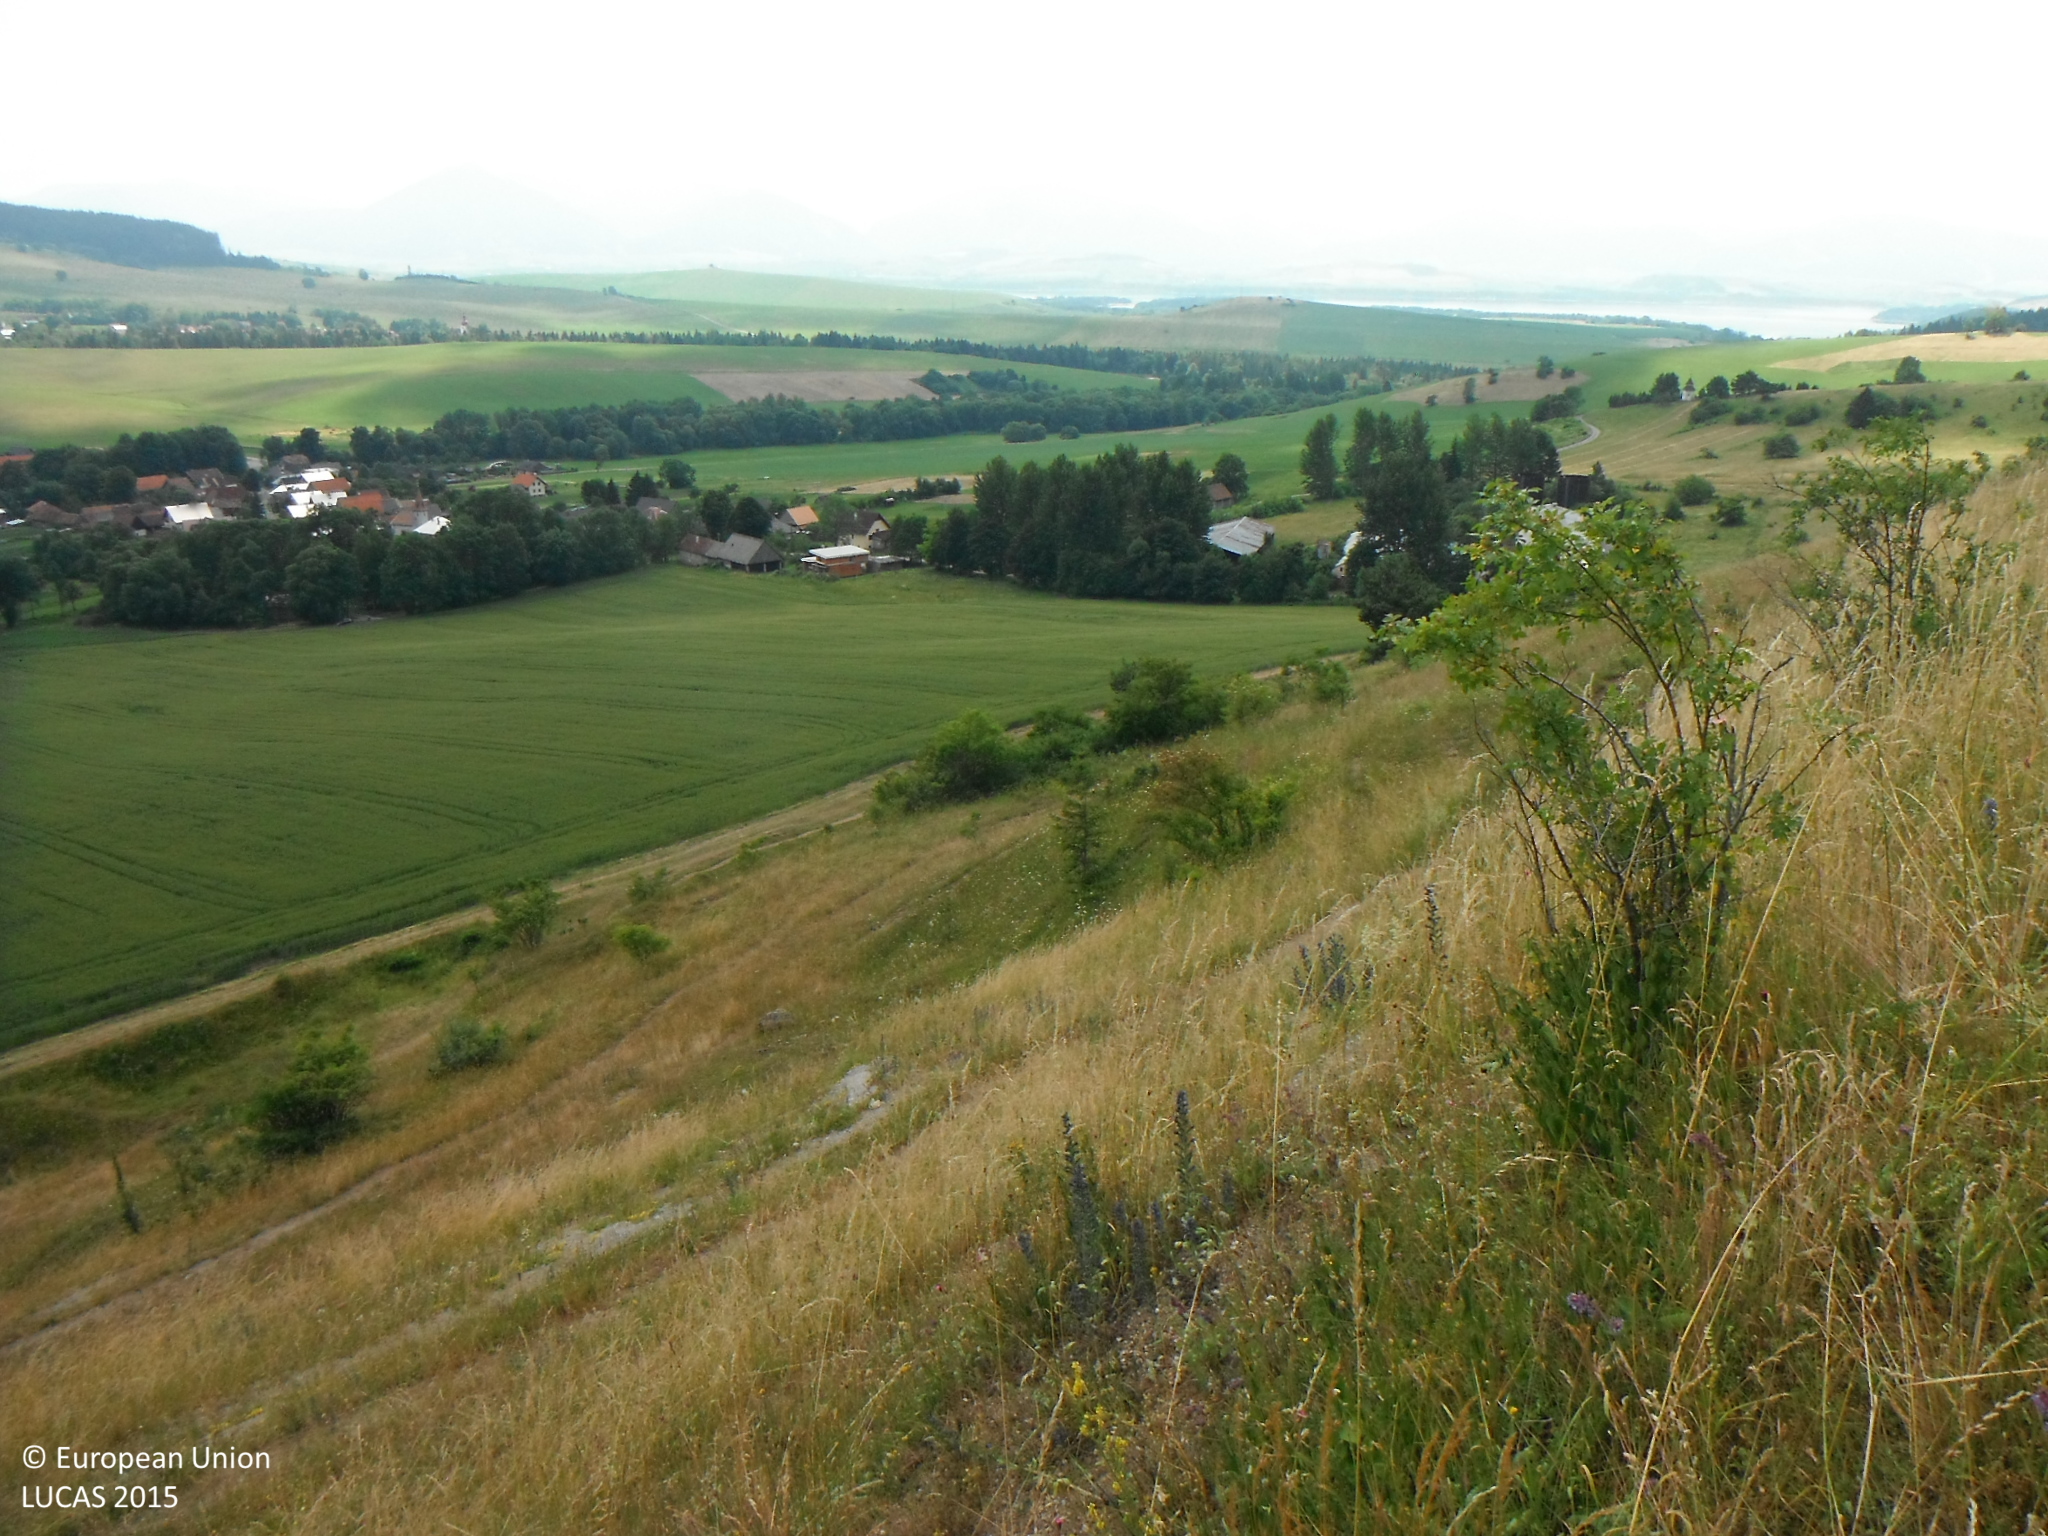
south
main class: Grassland
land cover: Grassland with sparse tree/shrub cover
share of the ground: > 75 %
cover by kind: herbaceous plants 90 %, broadleaved forest trees 5 %, shrubs 5 %
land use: Agriculture (excluding fallow land and kitchen gardens)
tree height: < 5 m
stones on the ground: 25 - 50 %
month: July
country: SK
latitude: 49.1684
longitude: 19.5312
